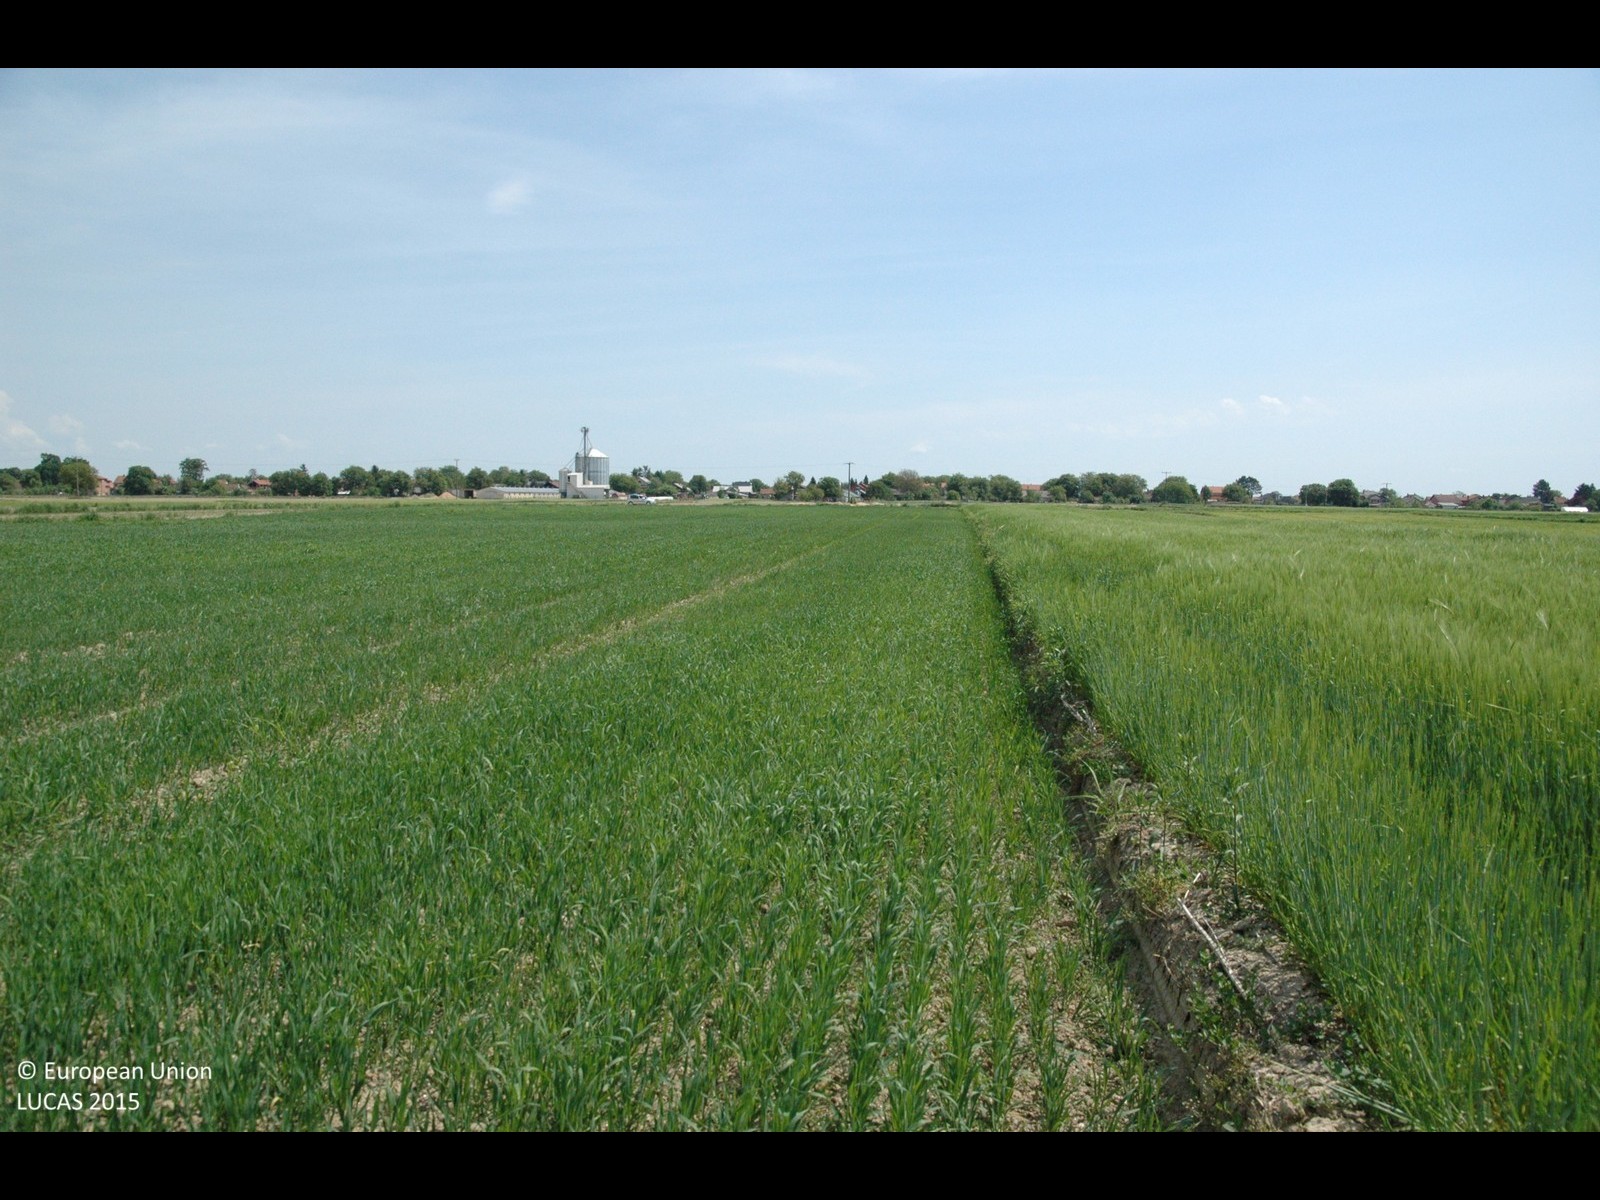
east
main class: Cropland
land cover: Common wheat
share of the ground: > 75 %
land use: Agriculture (excluding fallow land and kitchen gardens)
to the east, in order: Common wheat; Tracks; Sunflower
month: May
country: HR
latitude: 46.3429
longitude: 16.3538
